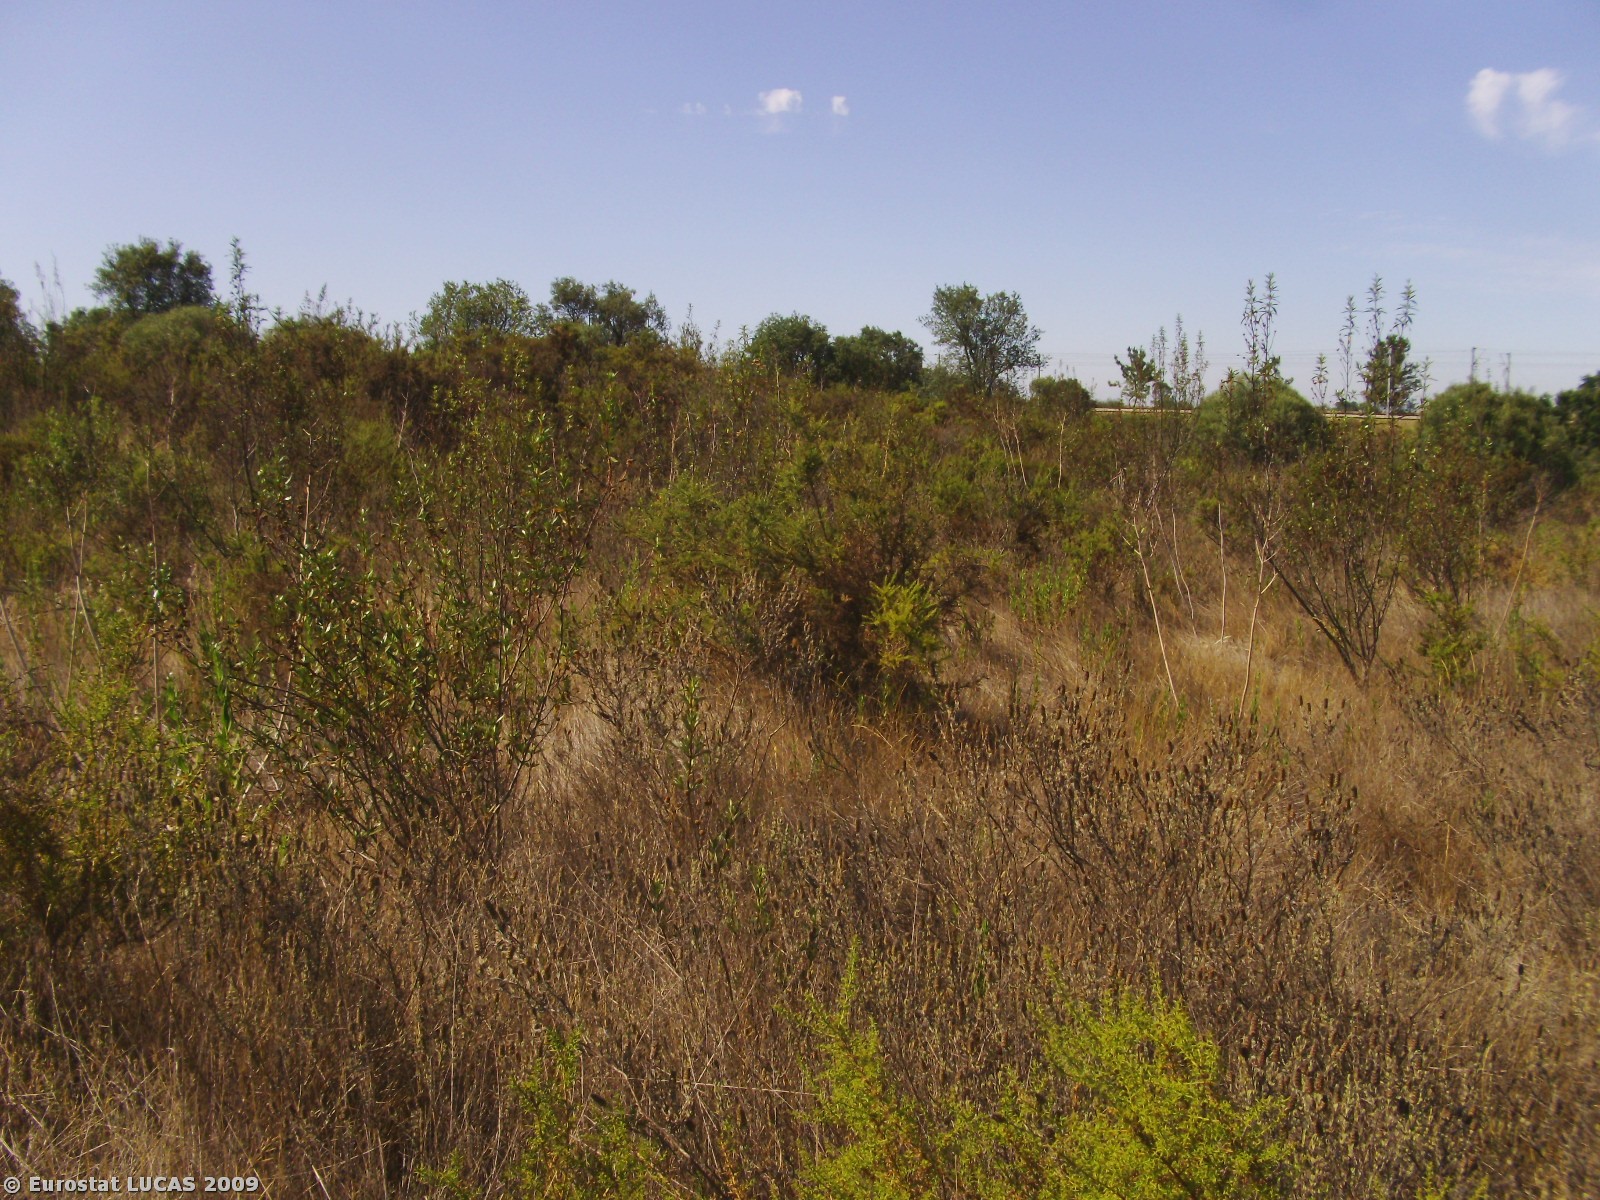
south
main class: Shrubland
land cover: Shrubland without tree cover
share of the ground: > 75 %
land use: Unused
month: August
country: PT
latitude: 38.6262
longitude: -8.7508
